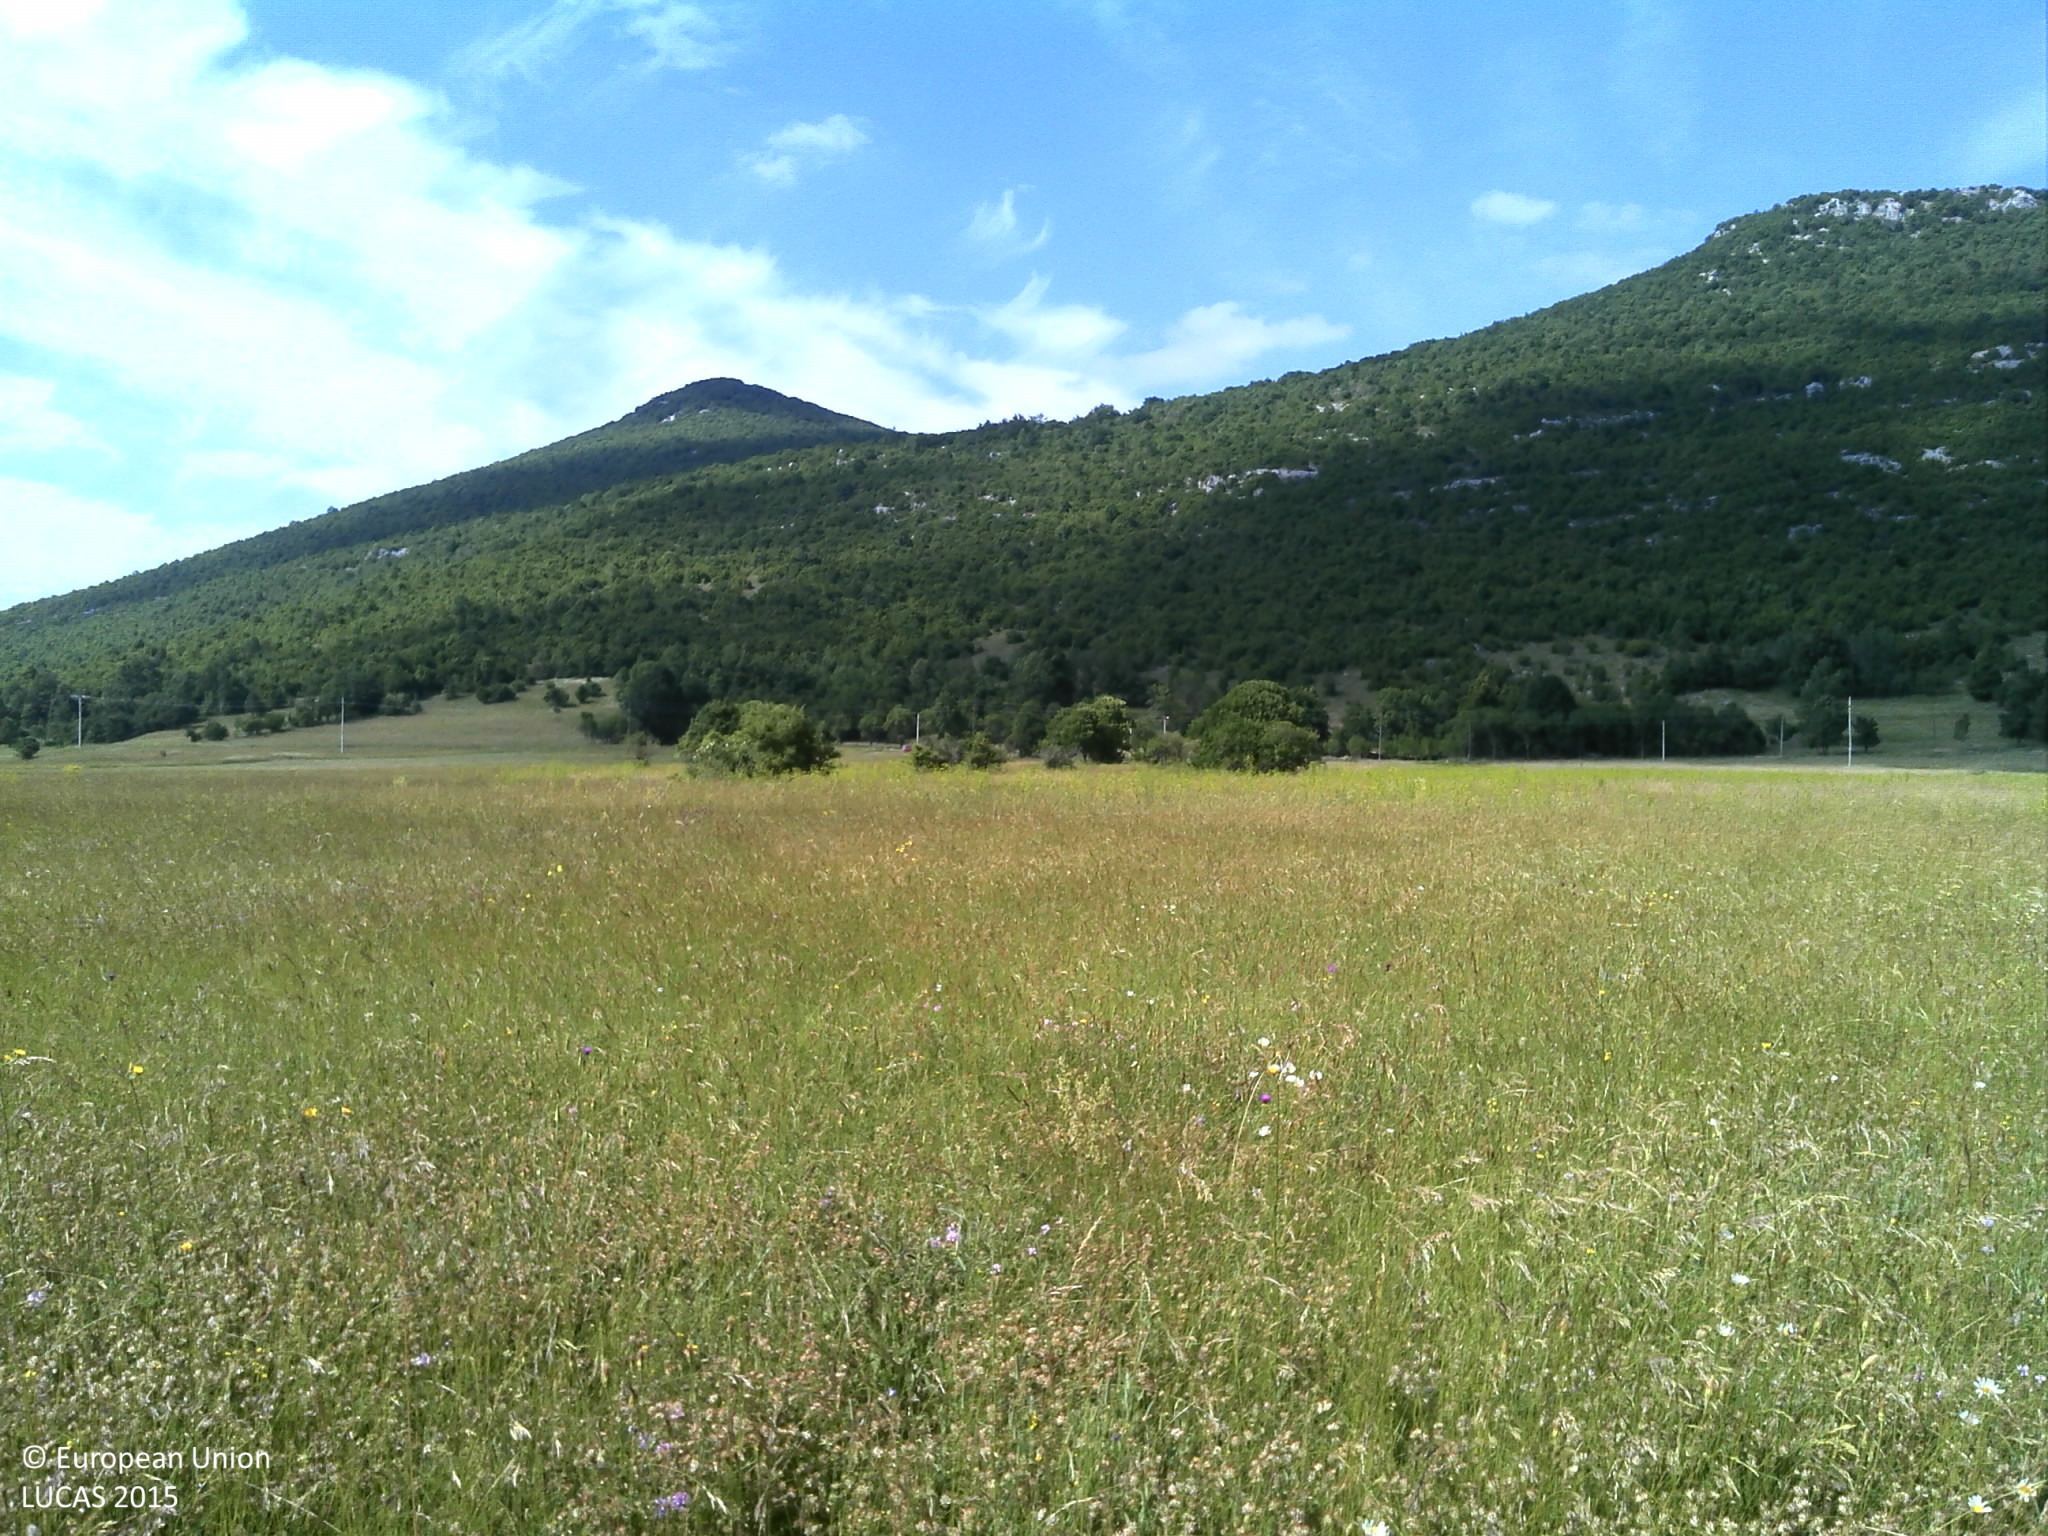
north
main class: Grassland
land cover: Grassland without tree/shrub cover
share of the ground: > 75 %
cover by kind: herbaceous plants 100 %
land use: Abandoned areas
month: June
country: HR
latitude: 44.4298
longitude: 15.6838
